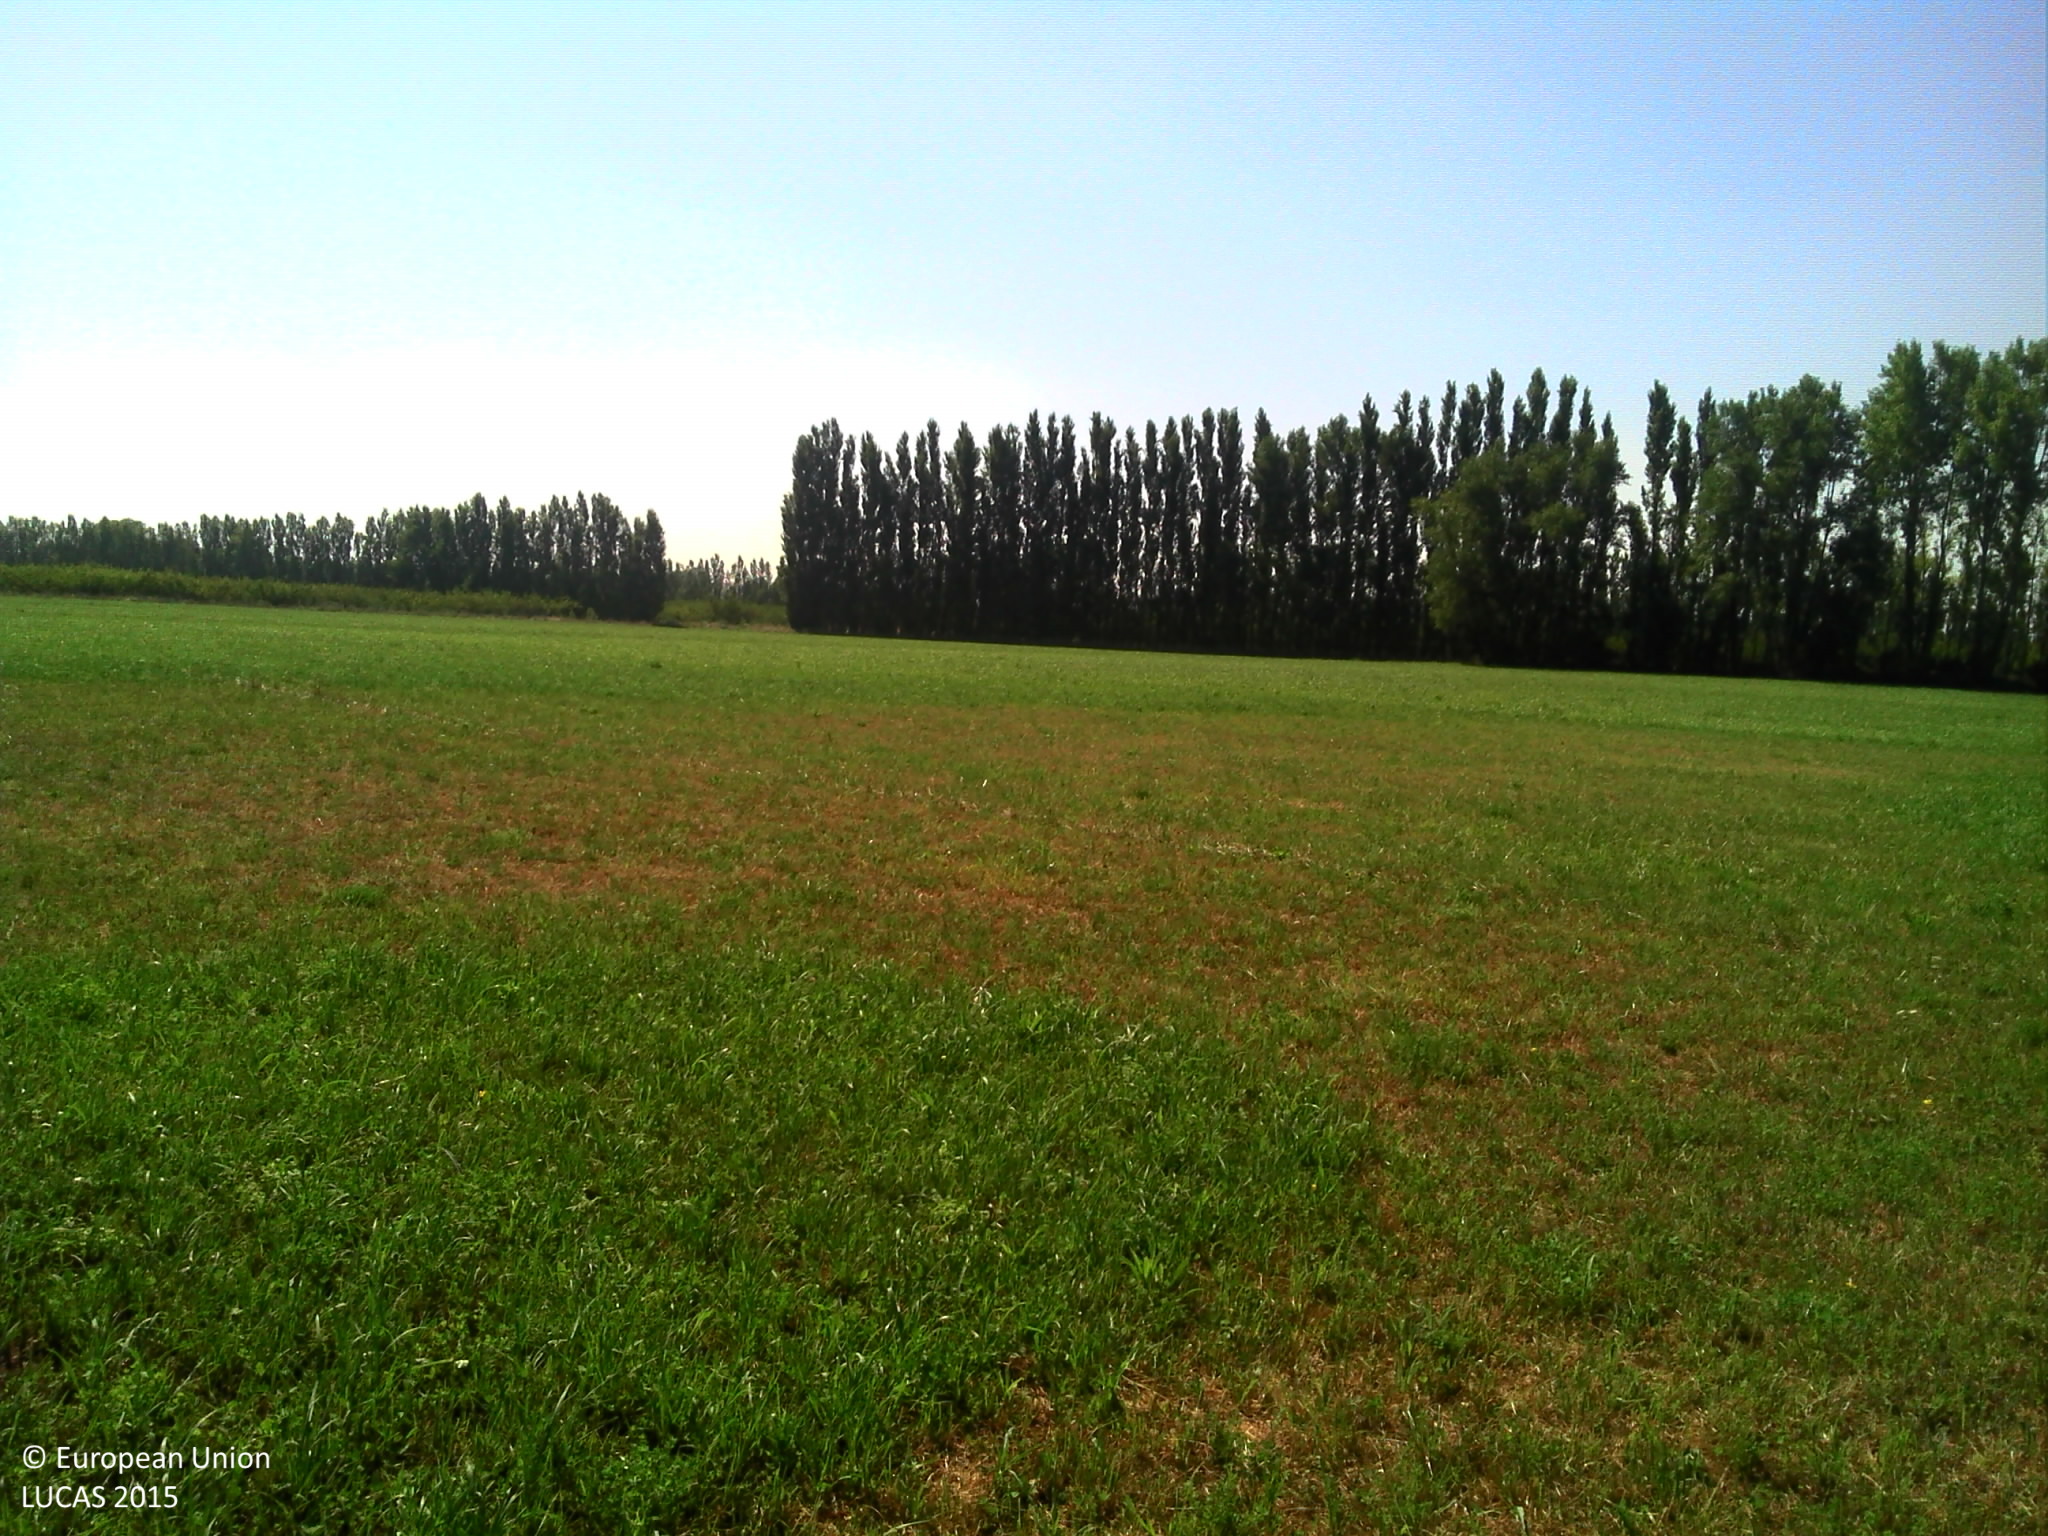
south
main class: Grassland
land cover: Grassland without tree/shrub cover
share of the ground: > 75 %
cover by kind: herbaceous plants 100 %
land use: Agriculture (excluding fallow land and kitchen gardens)
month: July
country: FR
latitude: 43.5848
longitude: 4.7462
